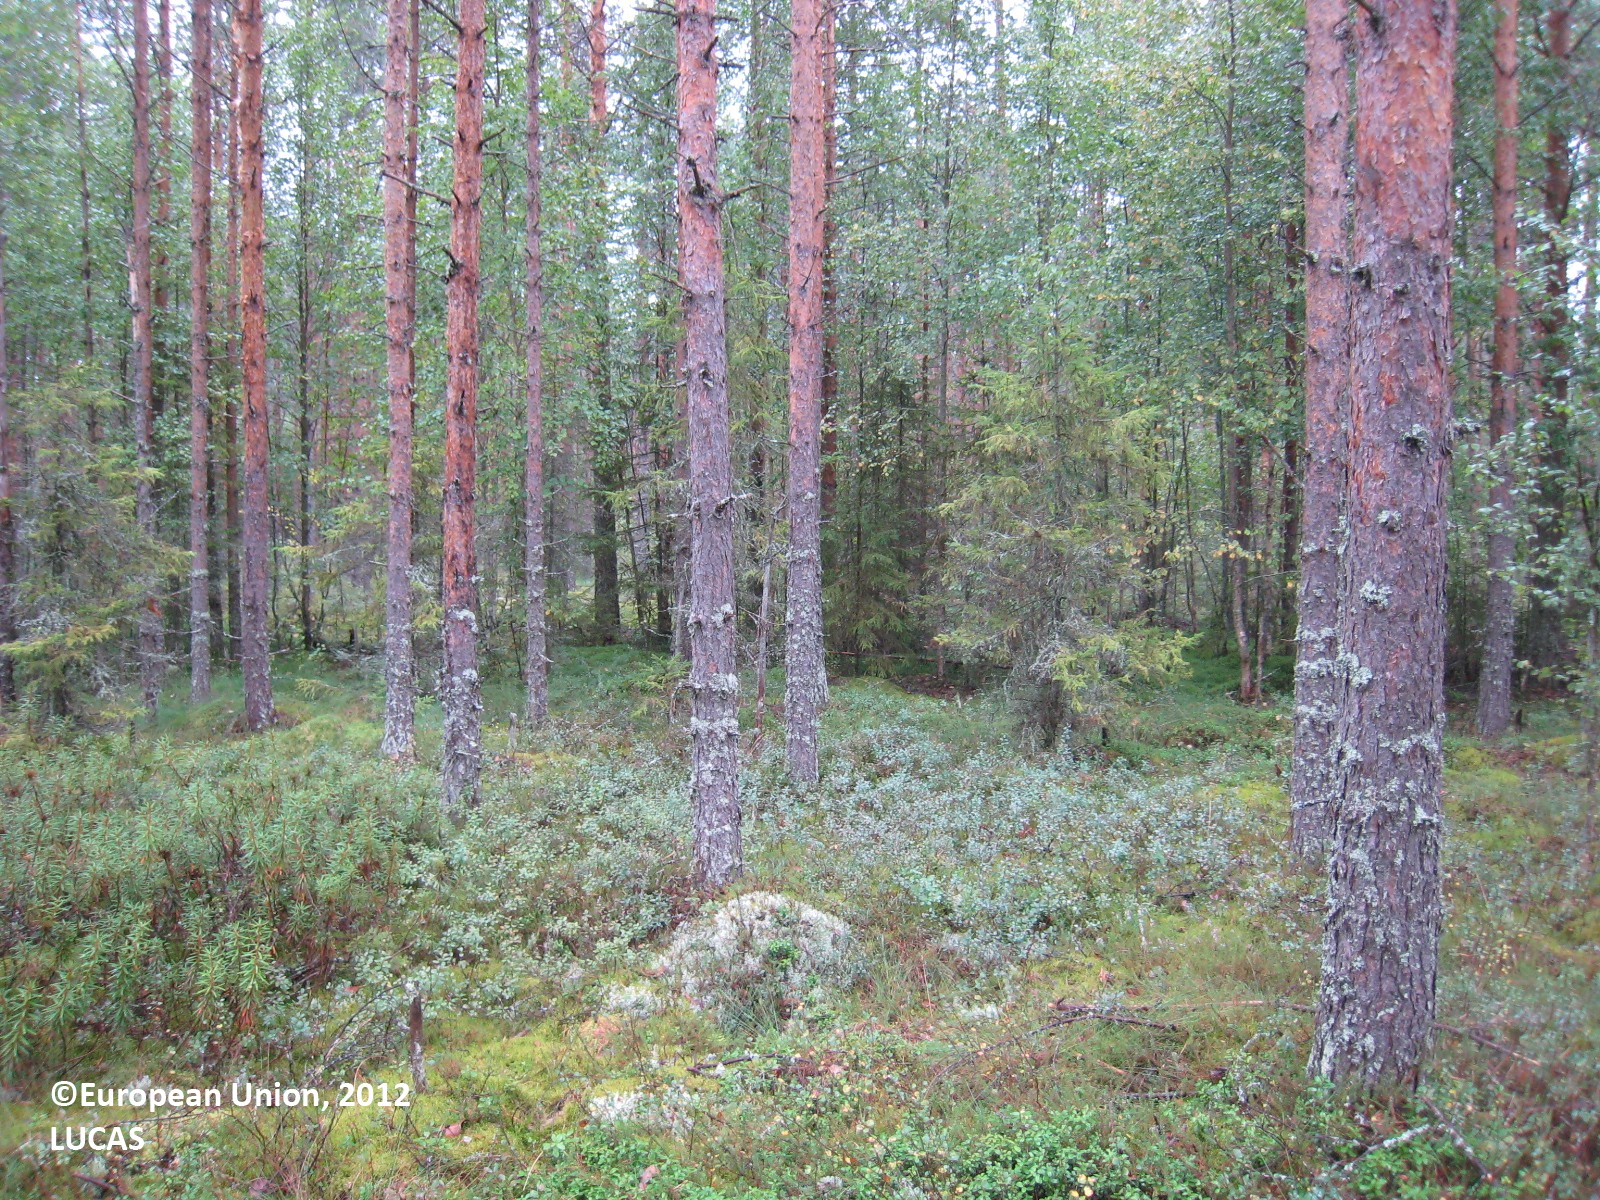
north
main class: Woodland
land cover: Pine dominated coniferous woodland
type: mire and swamp forests
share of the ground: 50 - 75 %
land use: Forestry
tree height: > 5 m
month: August
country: FI
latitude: 61.9083
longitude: 26.2218
